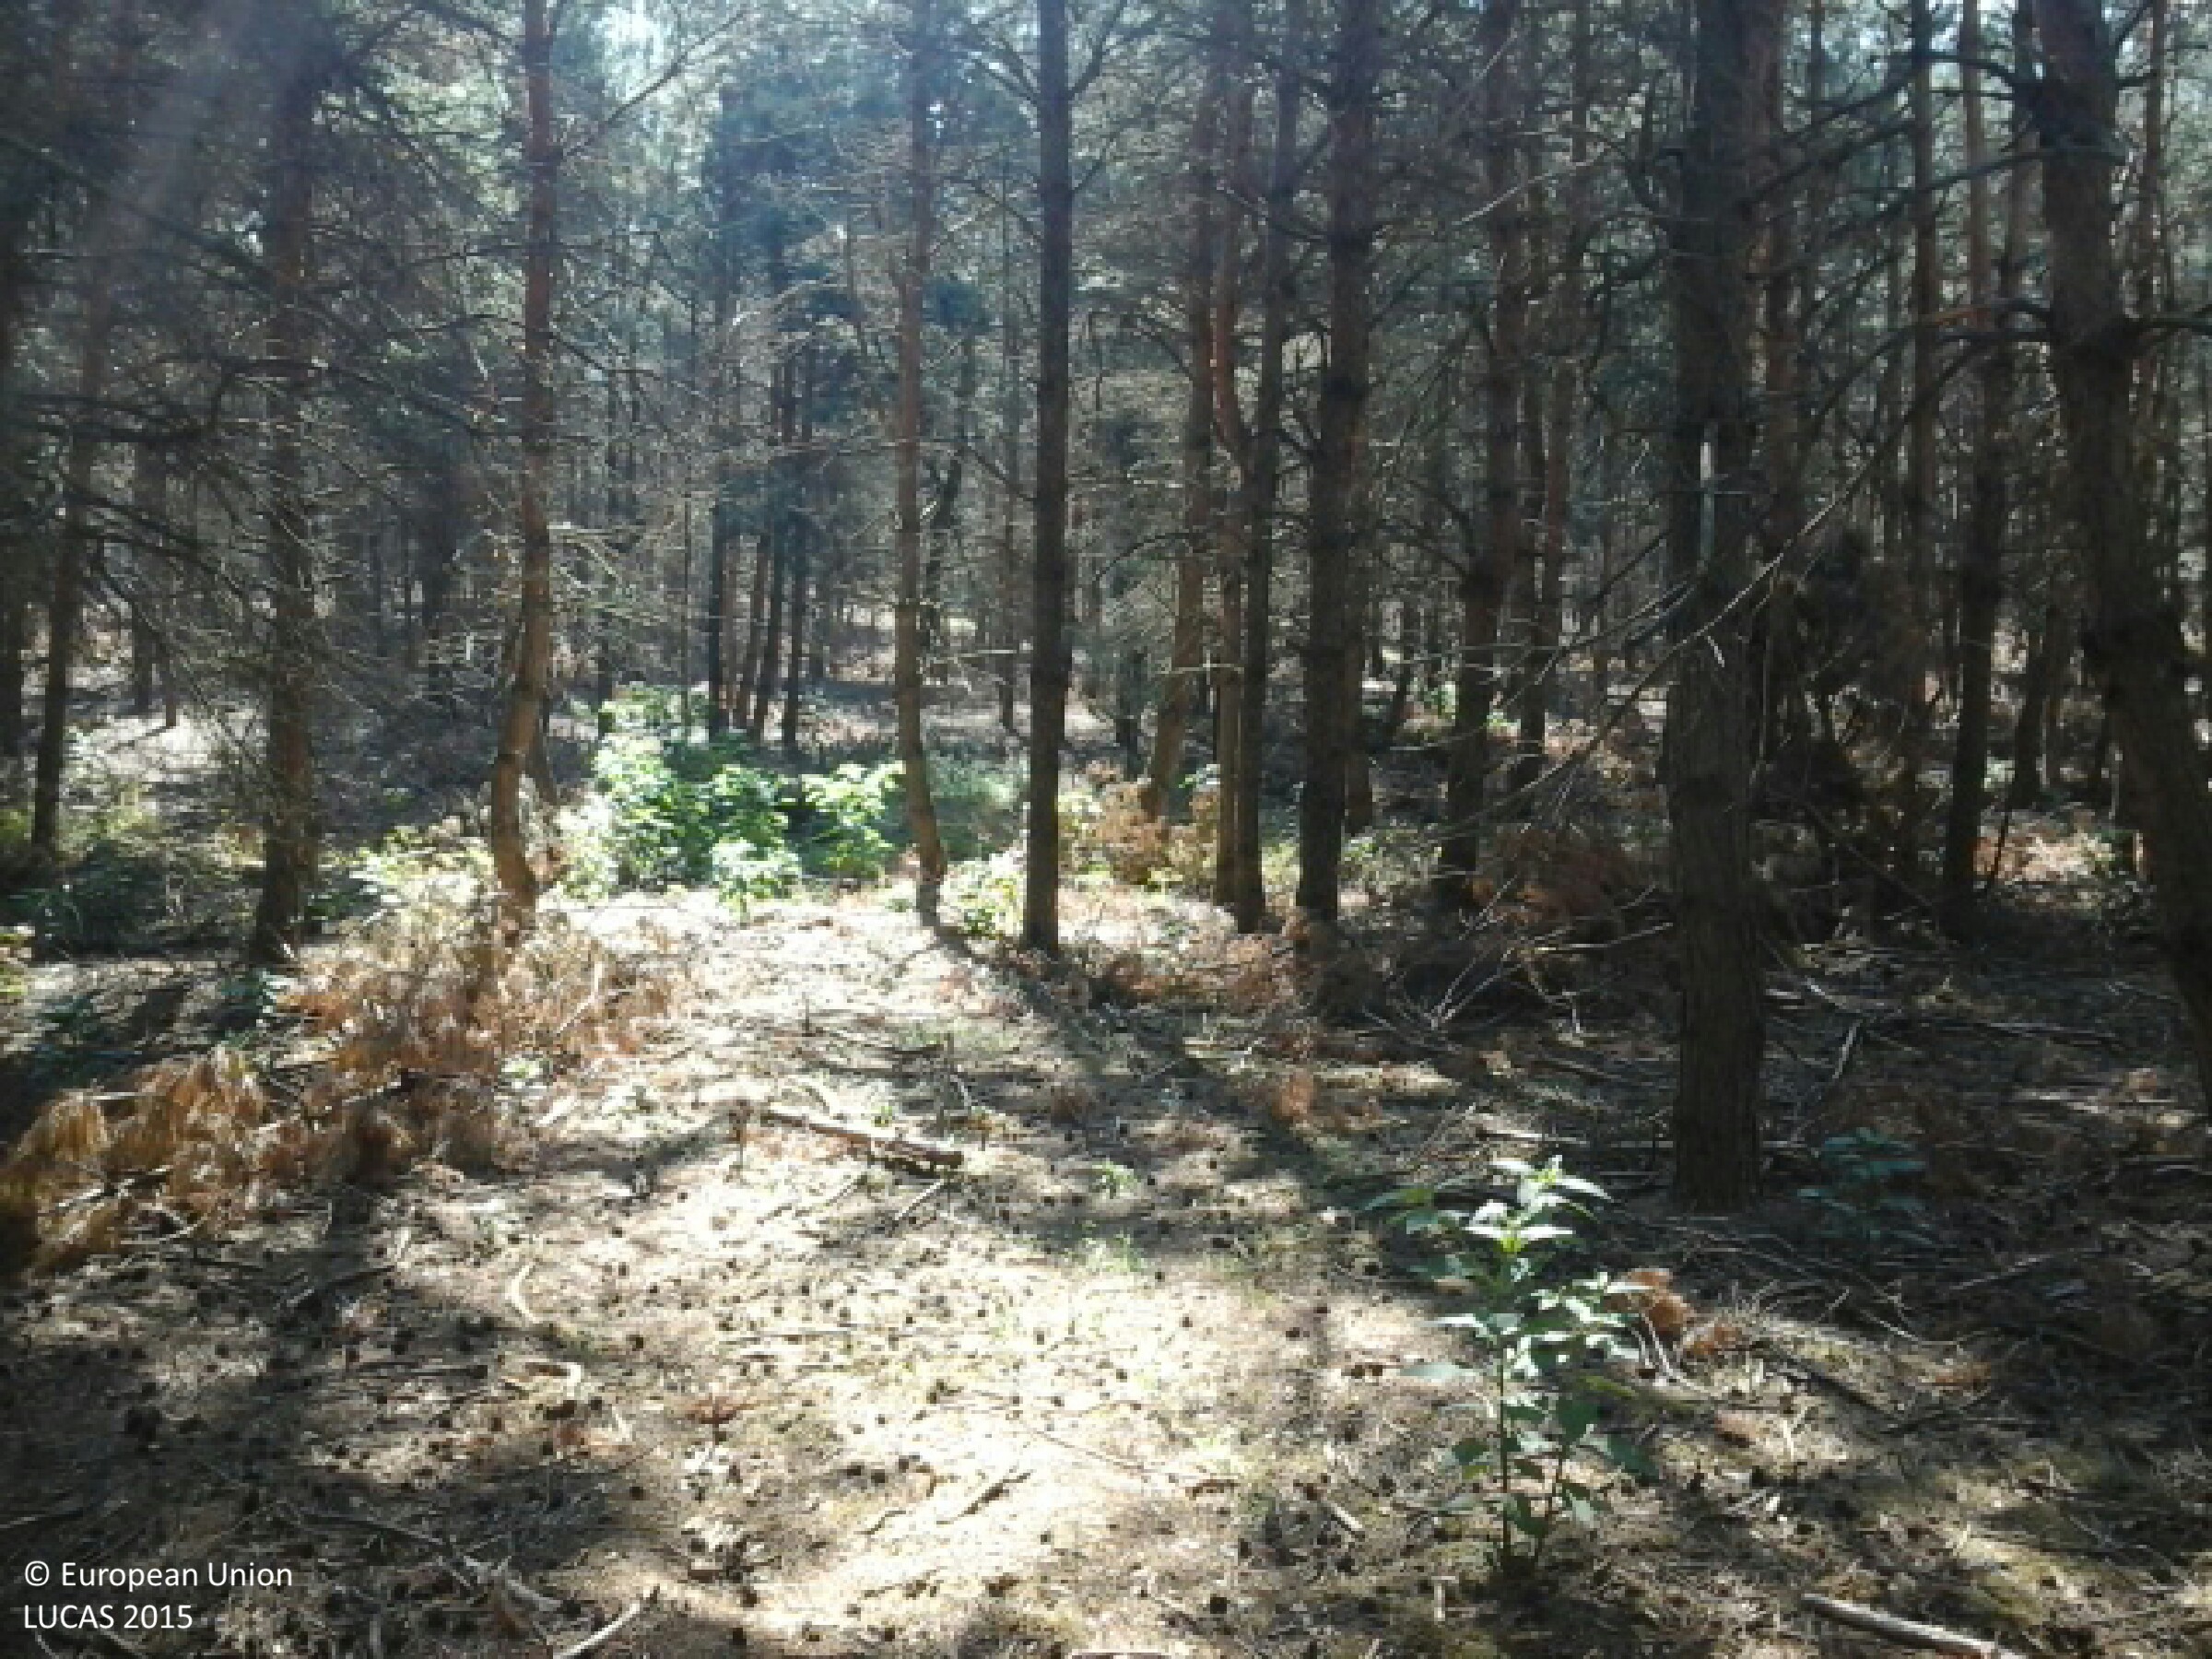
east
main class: Woodland
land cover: Pine dominated coniferous woodland
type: hemiboreal forest and nemoral coniferous forest and mixed broadleaved-coniferous forest
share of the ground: > 75 %
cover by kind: coniferous forest trees 85 %, consolidated bare surface 10 %, shrubs 5 %
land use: Forestry
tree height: > 5 m
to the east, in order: Pine dominated coniferous woodland; Broadleaved woodland; Tracks; Broadleaved woodland
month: July
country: HU
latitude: 47.9613
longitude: 22.2019
